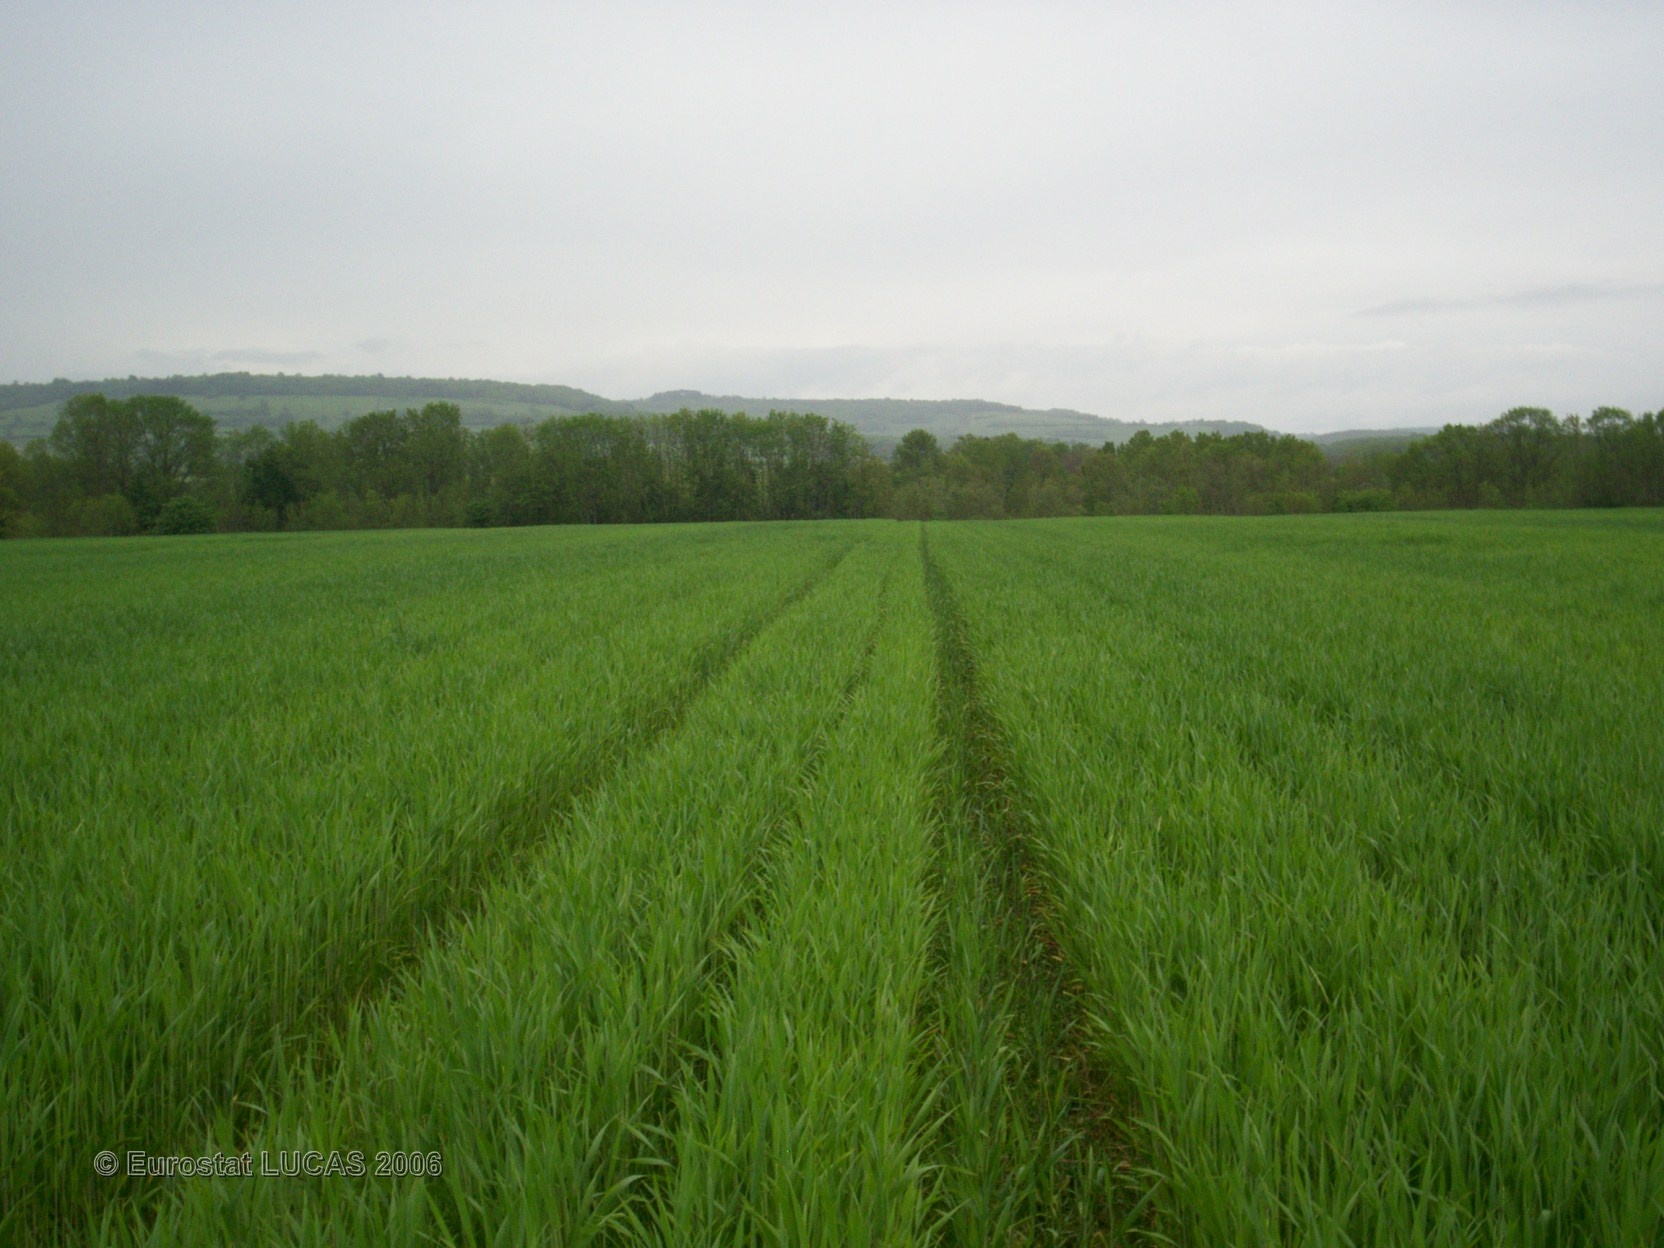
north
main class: Cropland
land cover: Barley
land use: Agriculture (excluding fallow land and kitchen gardens)
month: May
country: FR
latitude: 47.2253
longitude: 4.5984
